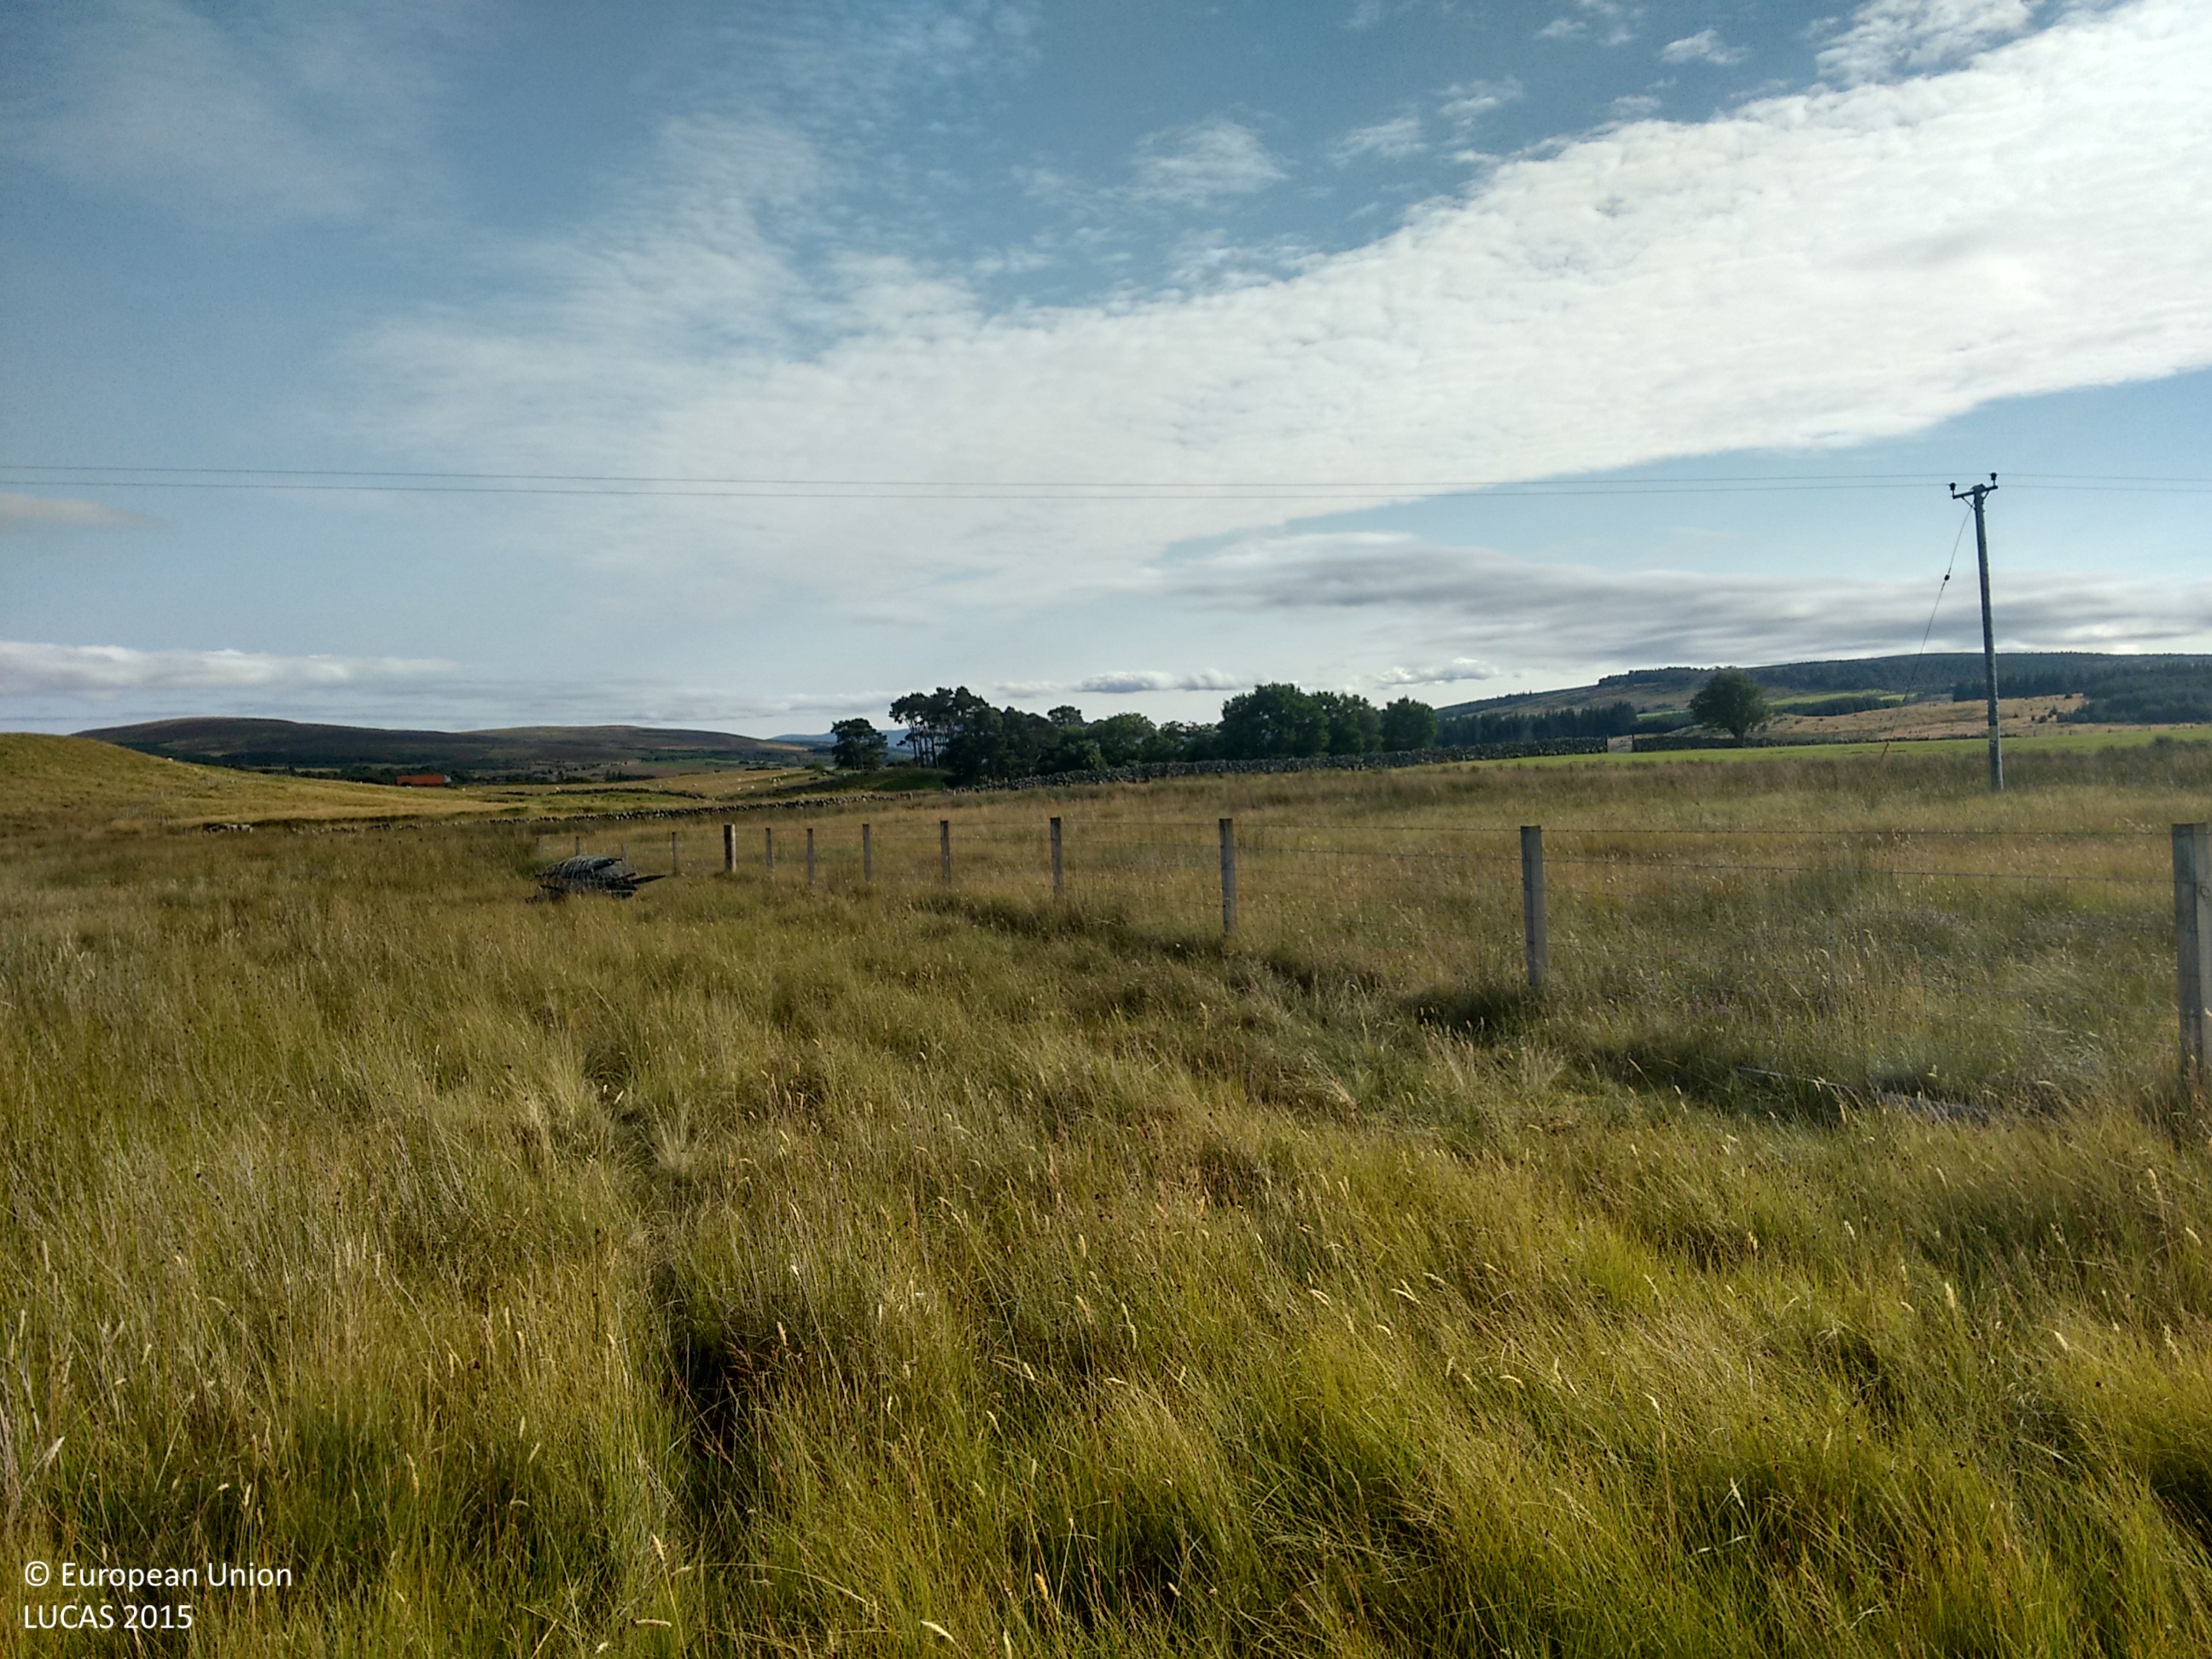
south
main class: Grassland
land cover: Grassland without tree/shrub cover
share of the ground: > 75 %
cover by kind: herbaceous plants 70 %, lichens and mosses 30 %
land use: Agriculture (excluding fallow land and kitchen gardens)
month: September
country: GB
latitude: 58.0041
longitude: -4.4186
